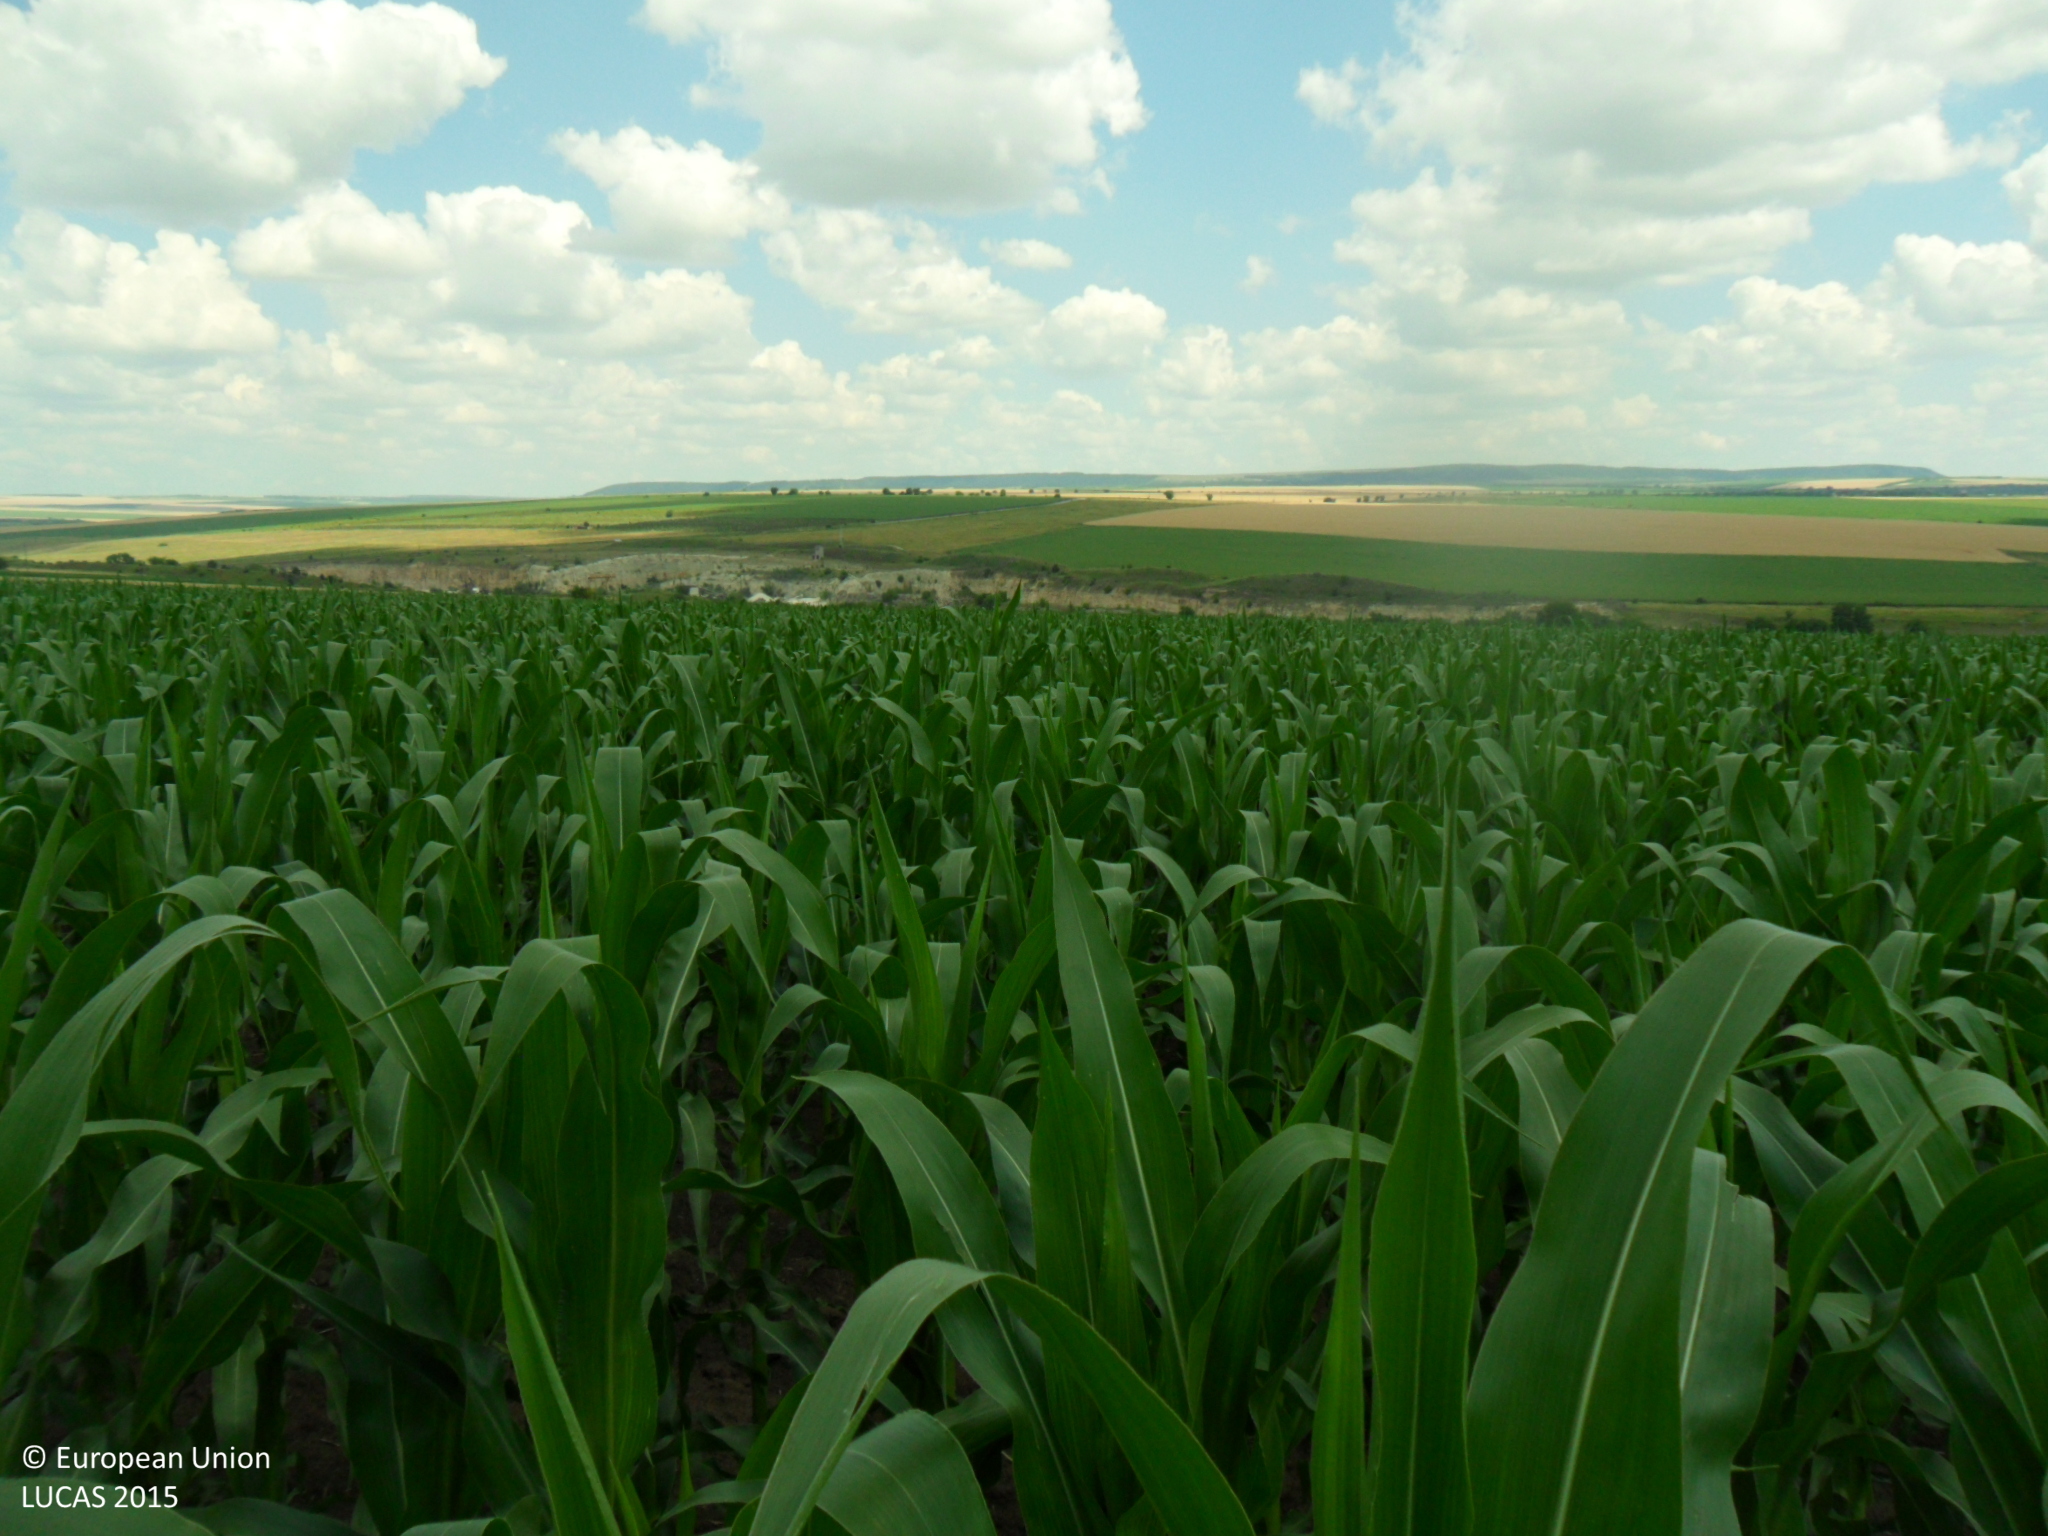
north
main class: Cropland
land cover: Maize
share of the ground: > 75 %
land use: Agriculture (excluding fallow land and kitchen gardens)
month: June
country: BG
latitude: 43.3491
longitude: 27.0555
